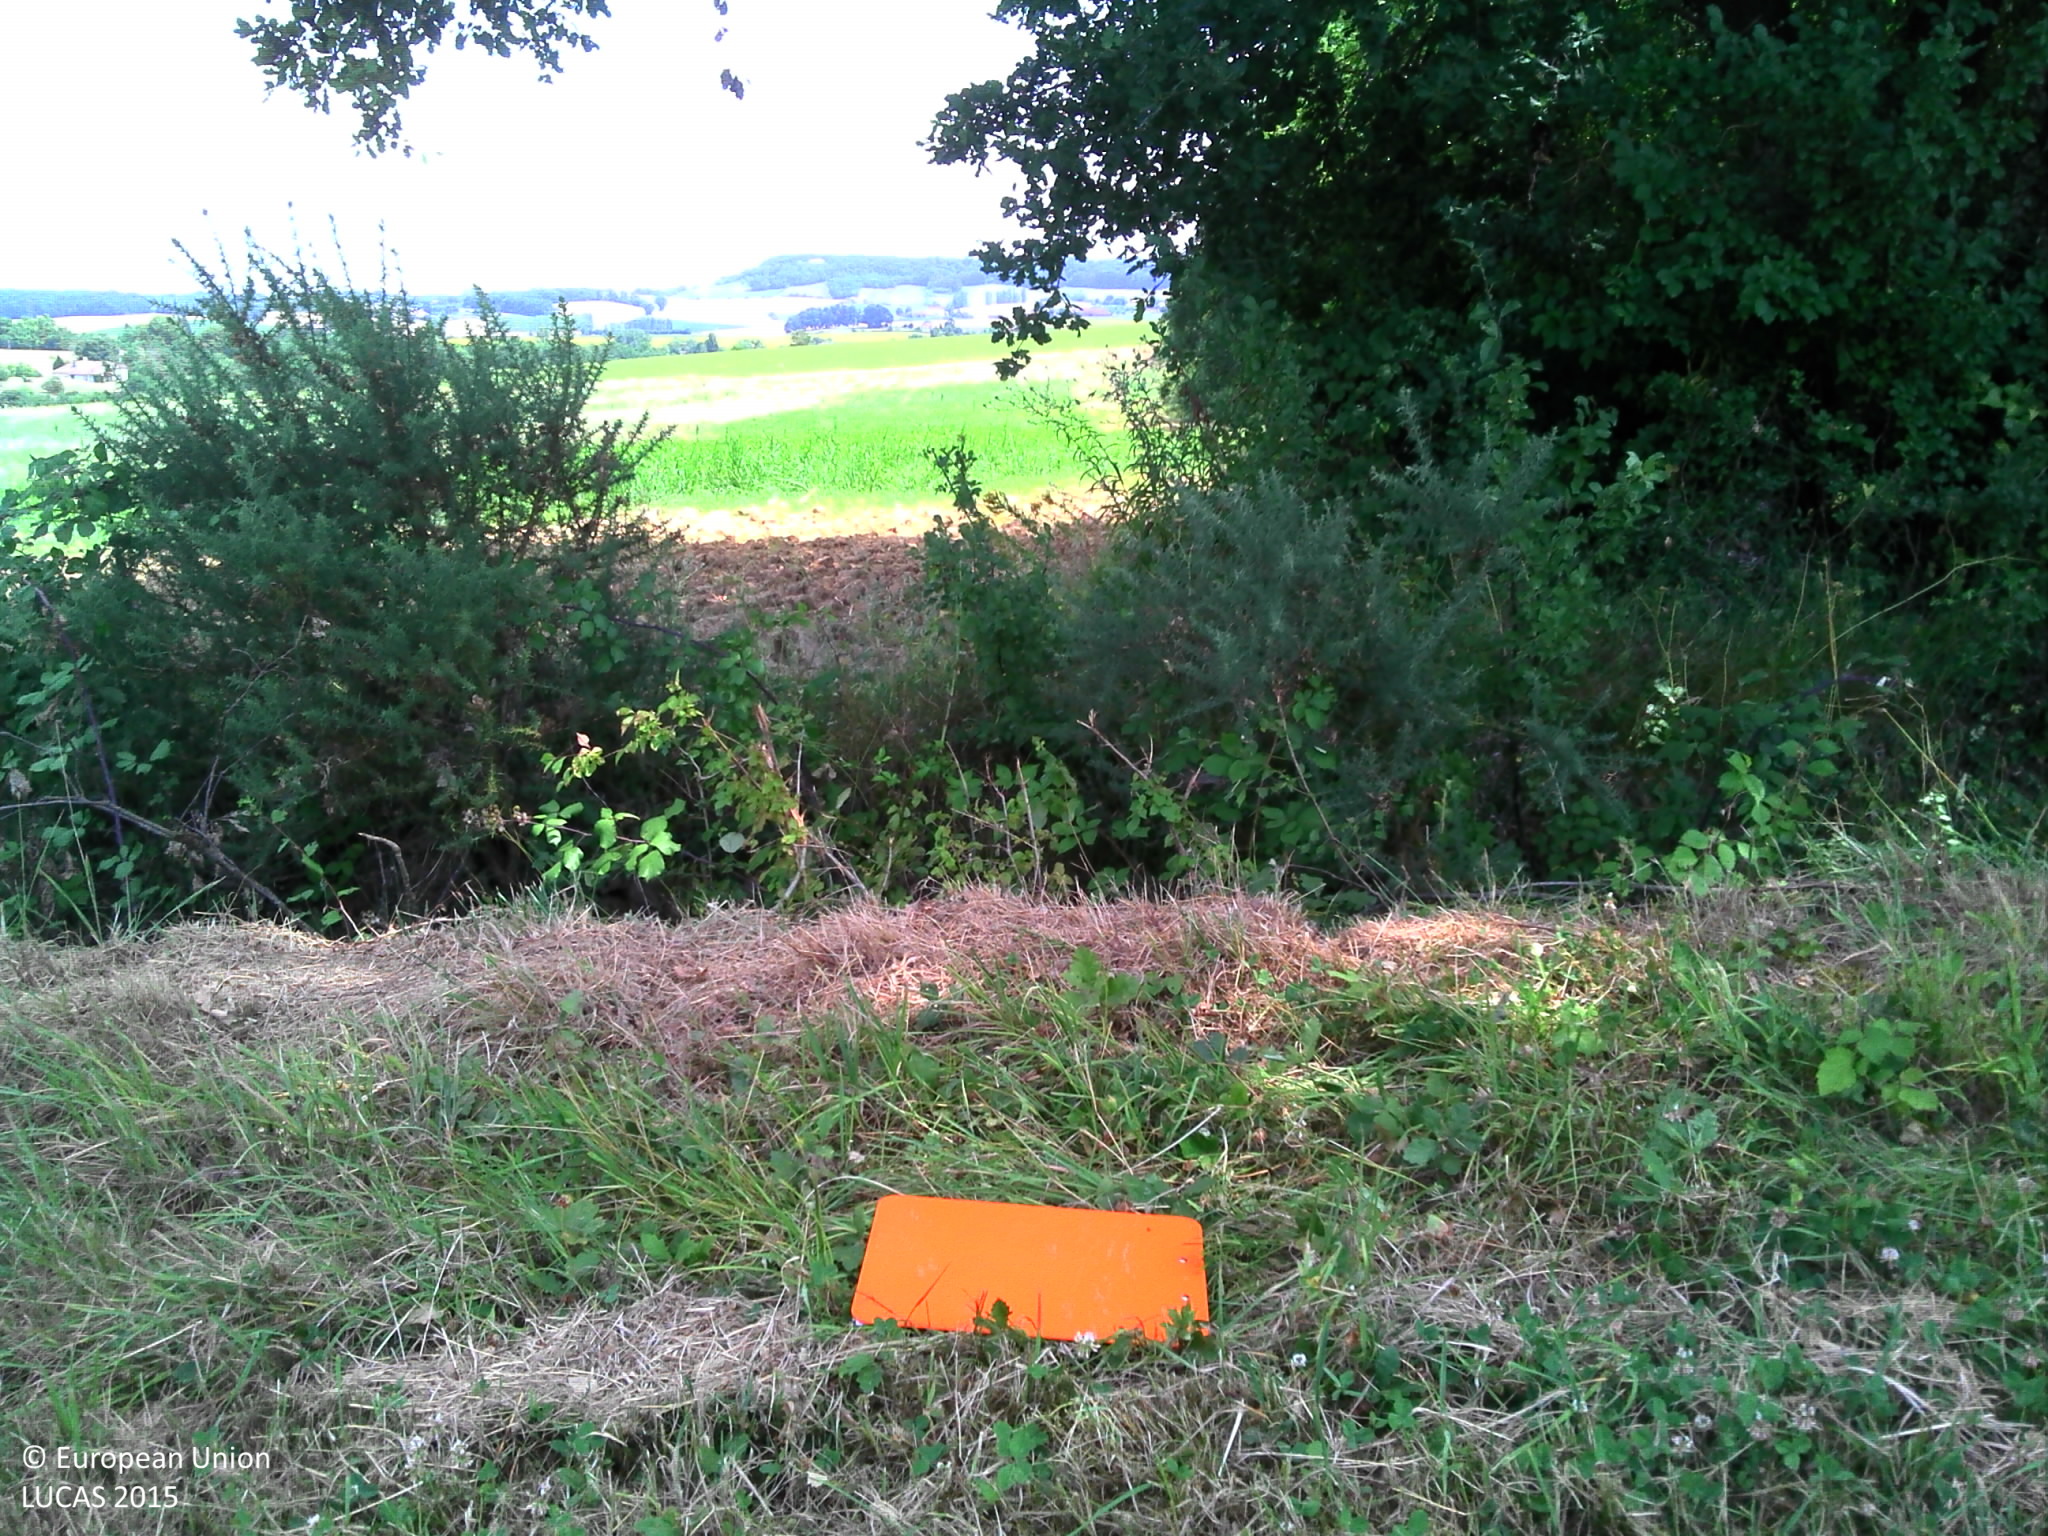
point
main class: Grassland
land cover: Grassland without tree/shrub cover
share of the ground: > 75 %
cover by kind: herbaceous plants 100 %
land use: Agriculture (excluding fallow land and kitchen gardens)
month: July
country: FR
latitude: 44.5079
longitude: 0.8498
